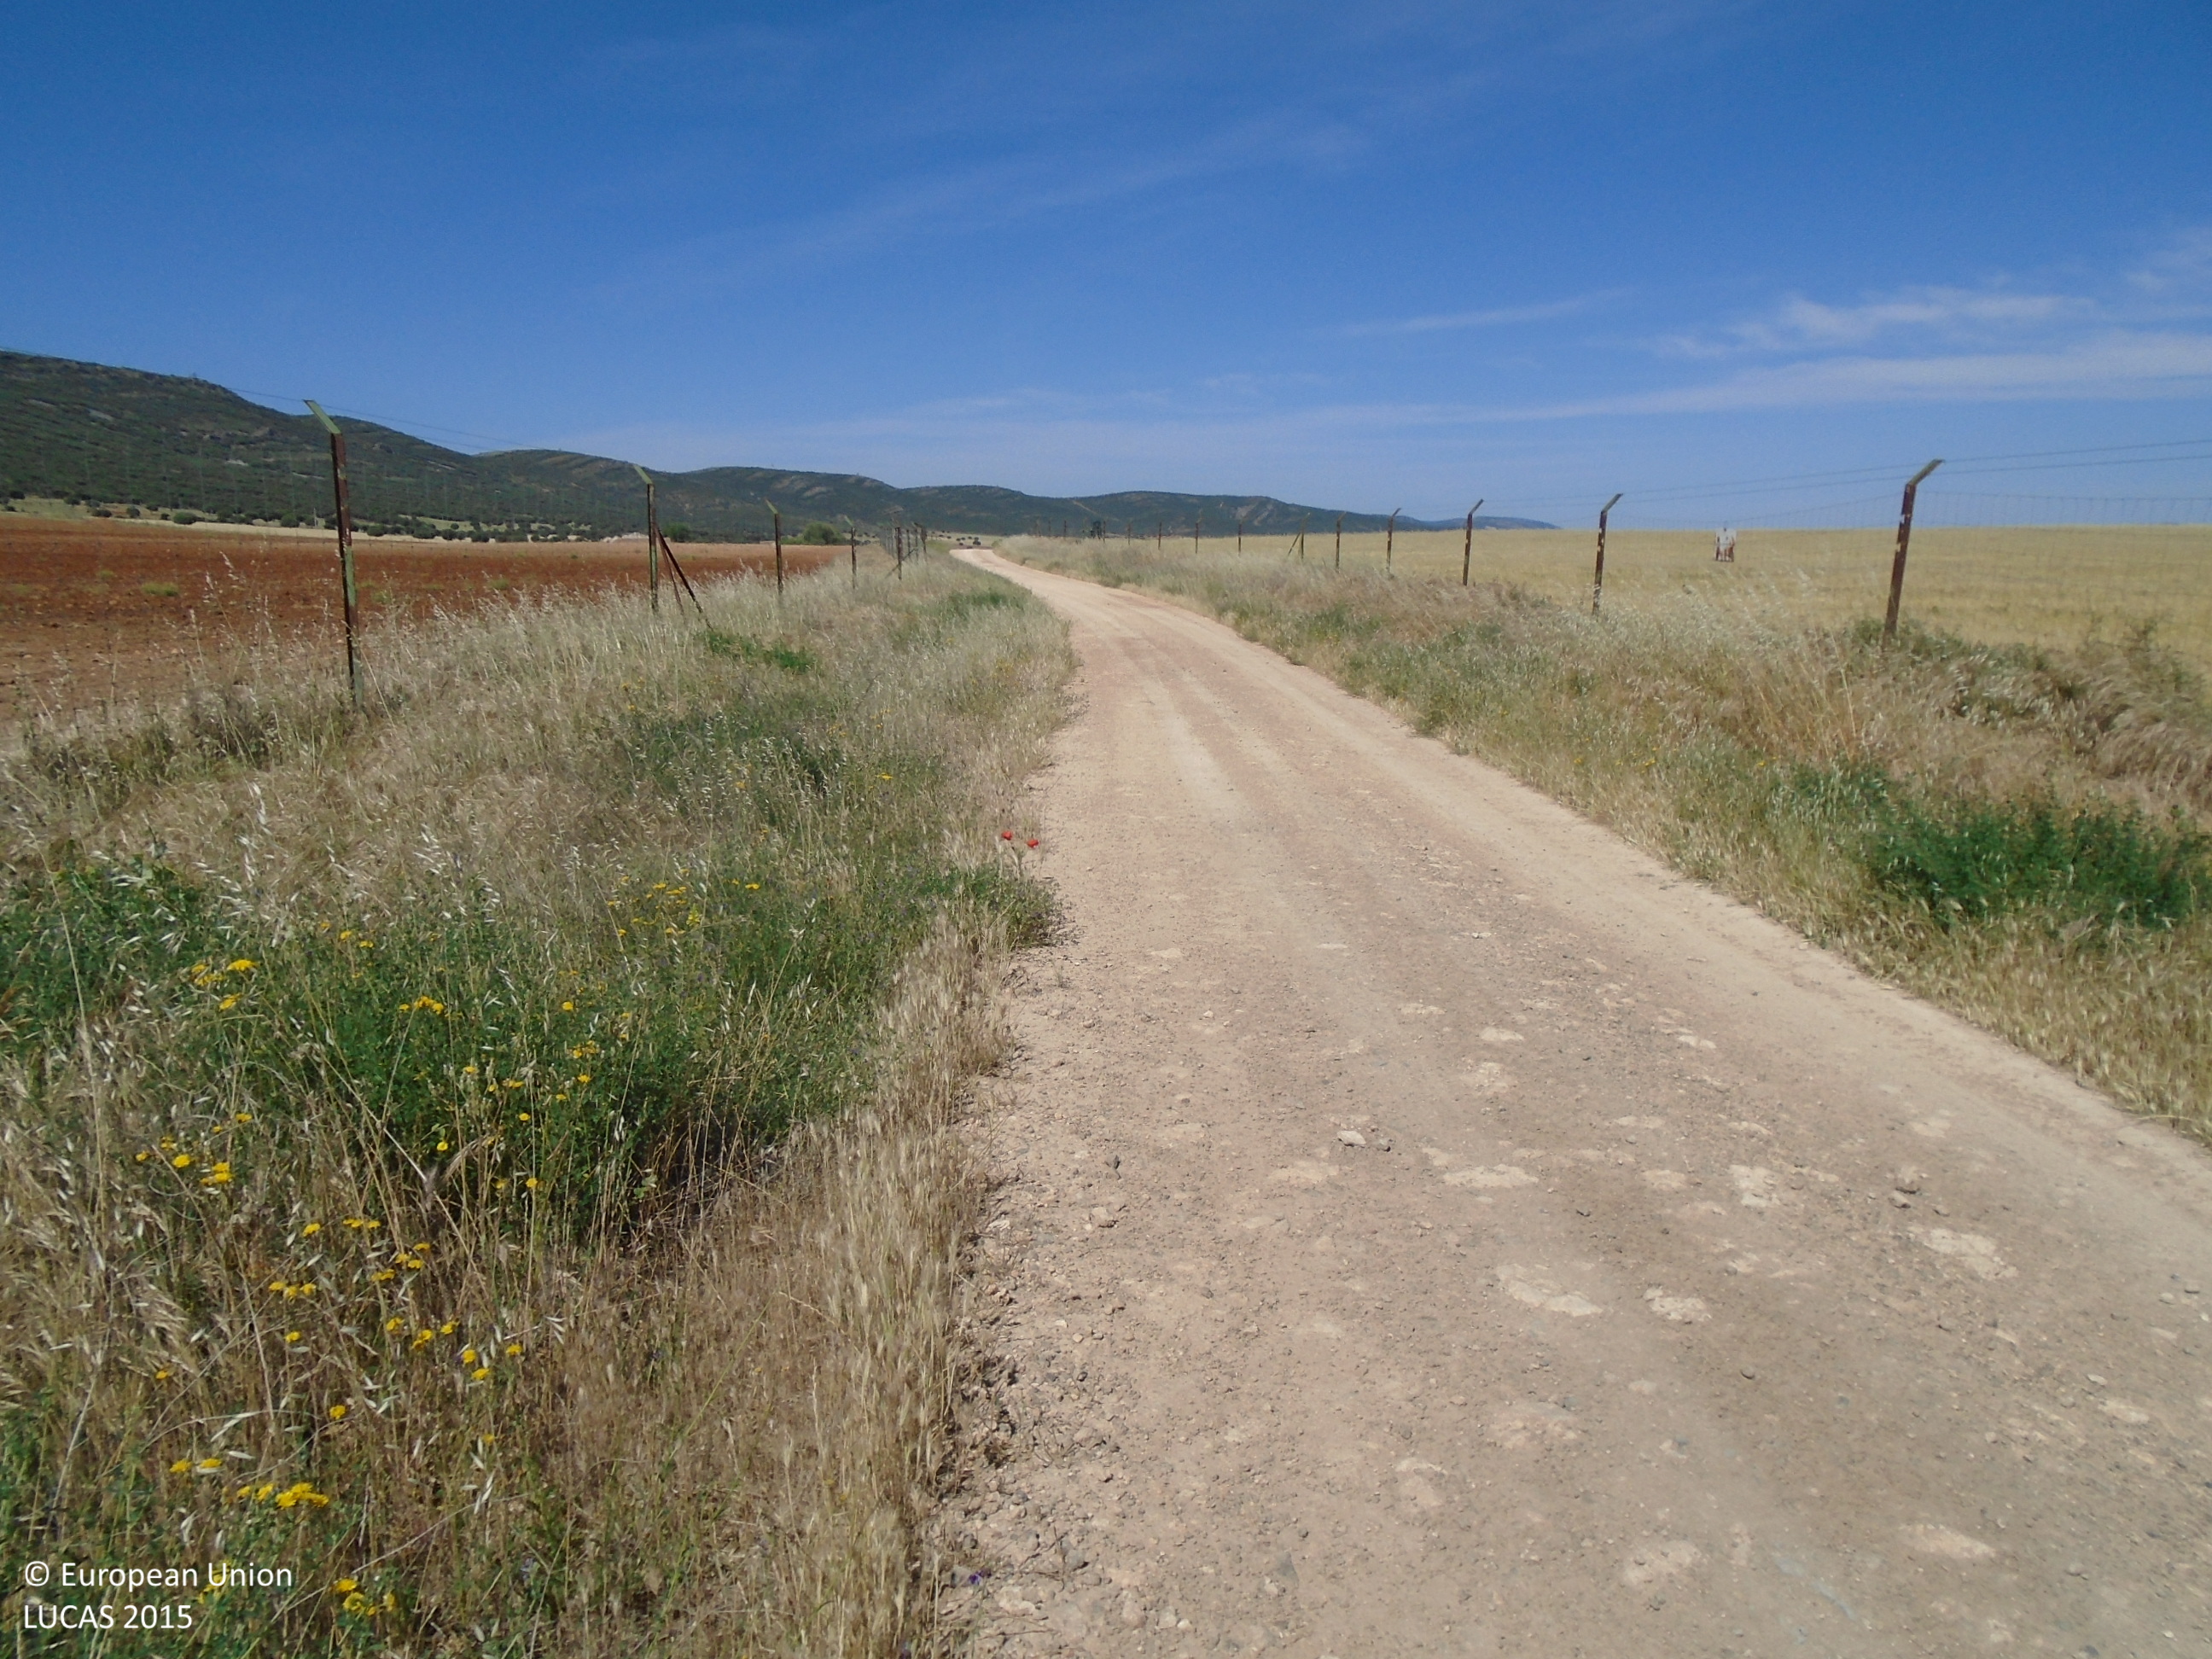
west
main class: Woodland
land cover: Broadleaved woodland
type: broadleaved evergreen forest
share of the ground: > 75 %
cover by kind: broadleaved forest trees 60 %, shrubs 30 %, herbaceous plants 5 %, consolidated bare surface 5 %
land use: Other primary production
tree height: > 5 m
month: May
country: ES
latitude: 39.4622
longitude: -3.7280
